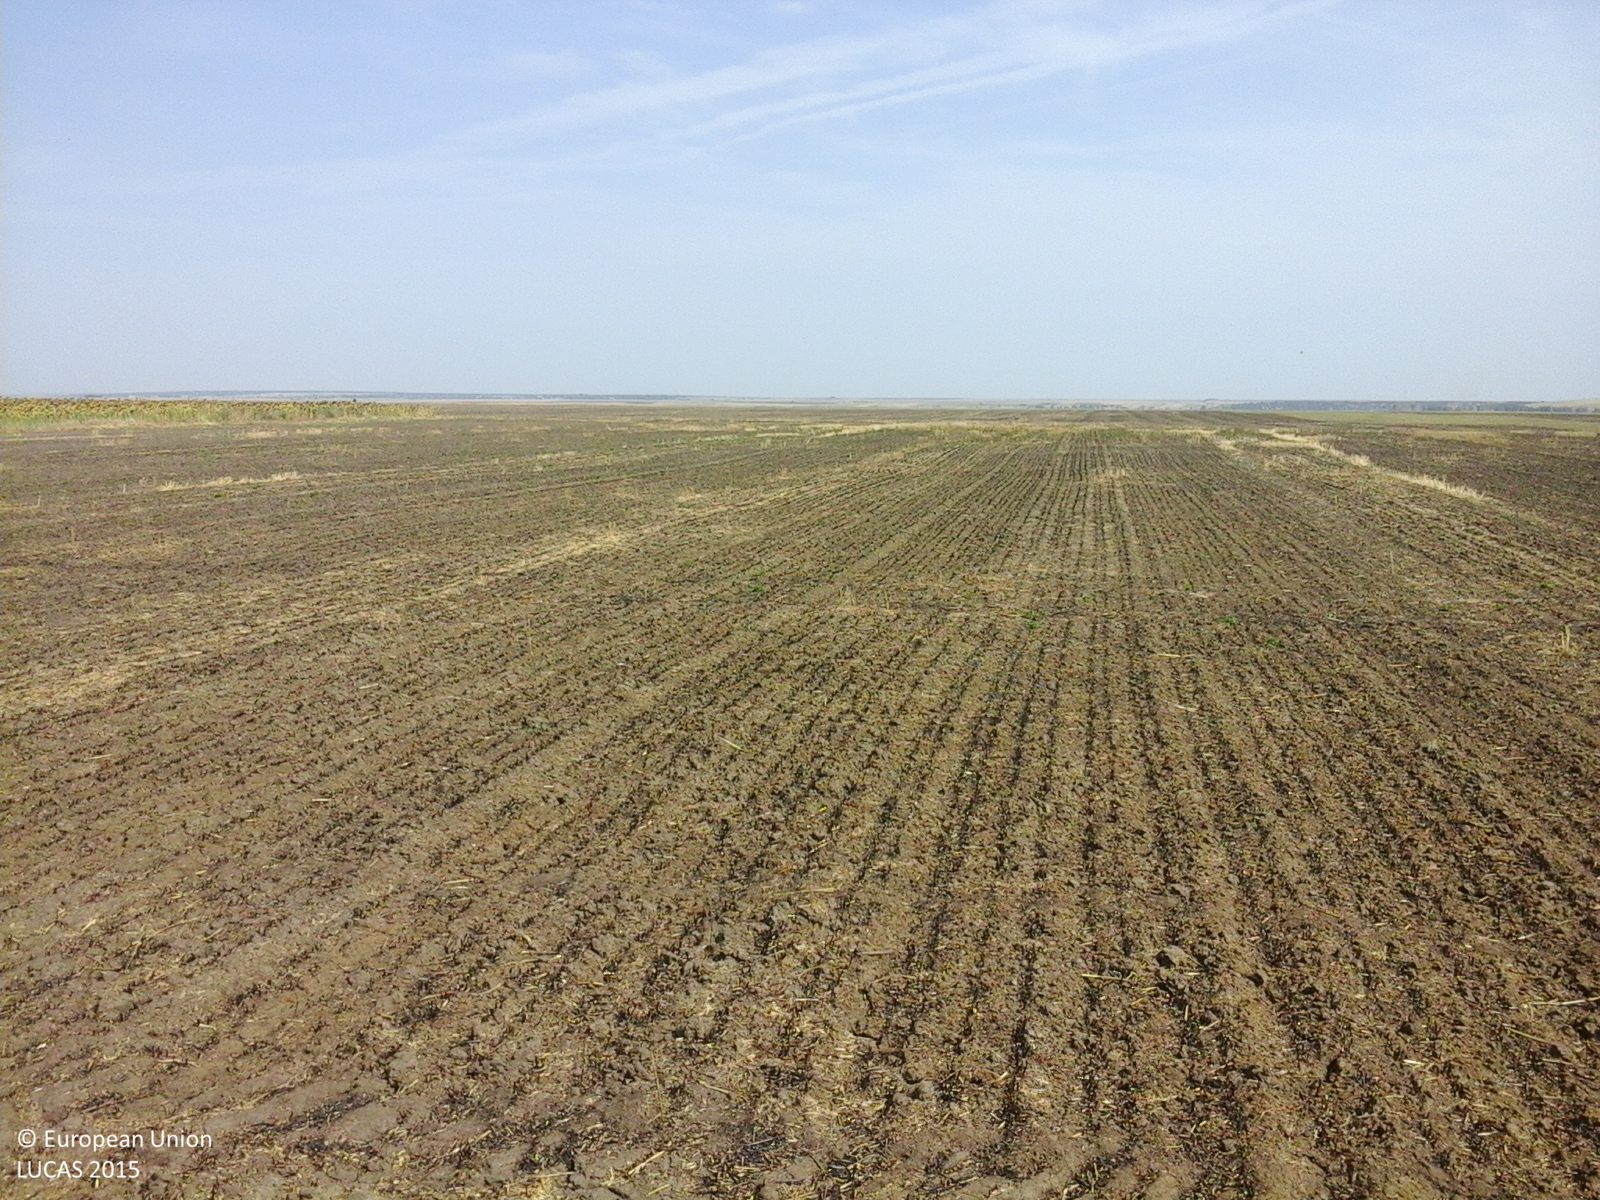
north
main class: Cropland
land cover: Durum wheat
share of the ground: 10 - 25 %
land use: Agriculture (excluding fallow land and kitchen gardens)
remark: Burnt area
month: August
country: RO
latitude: 44.1378
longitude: 23.2334
